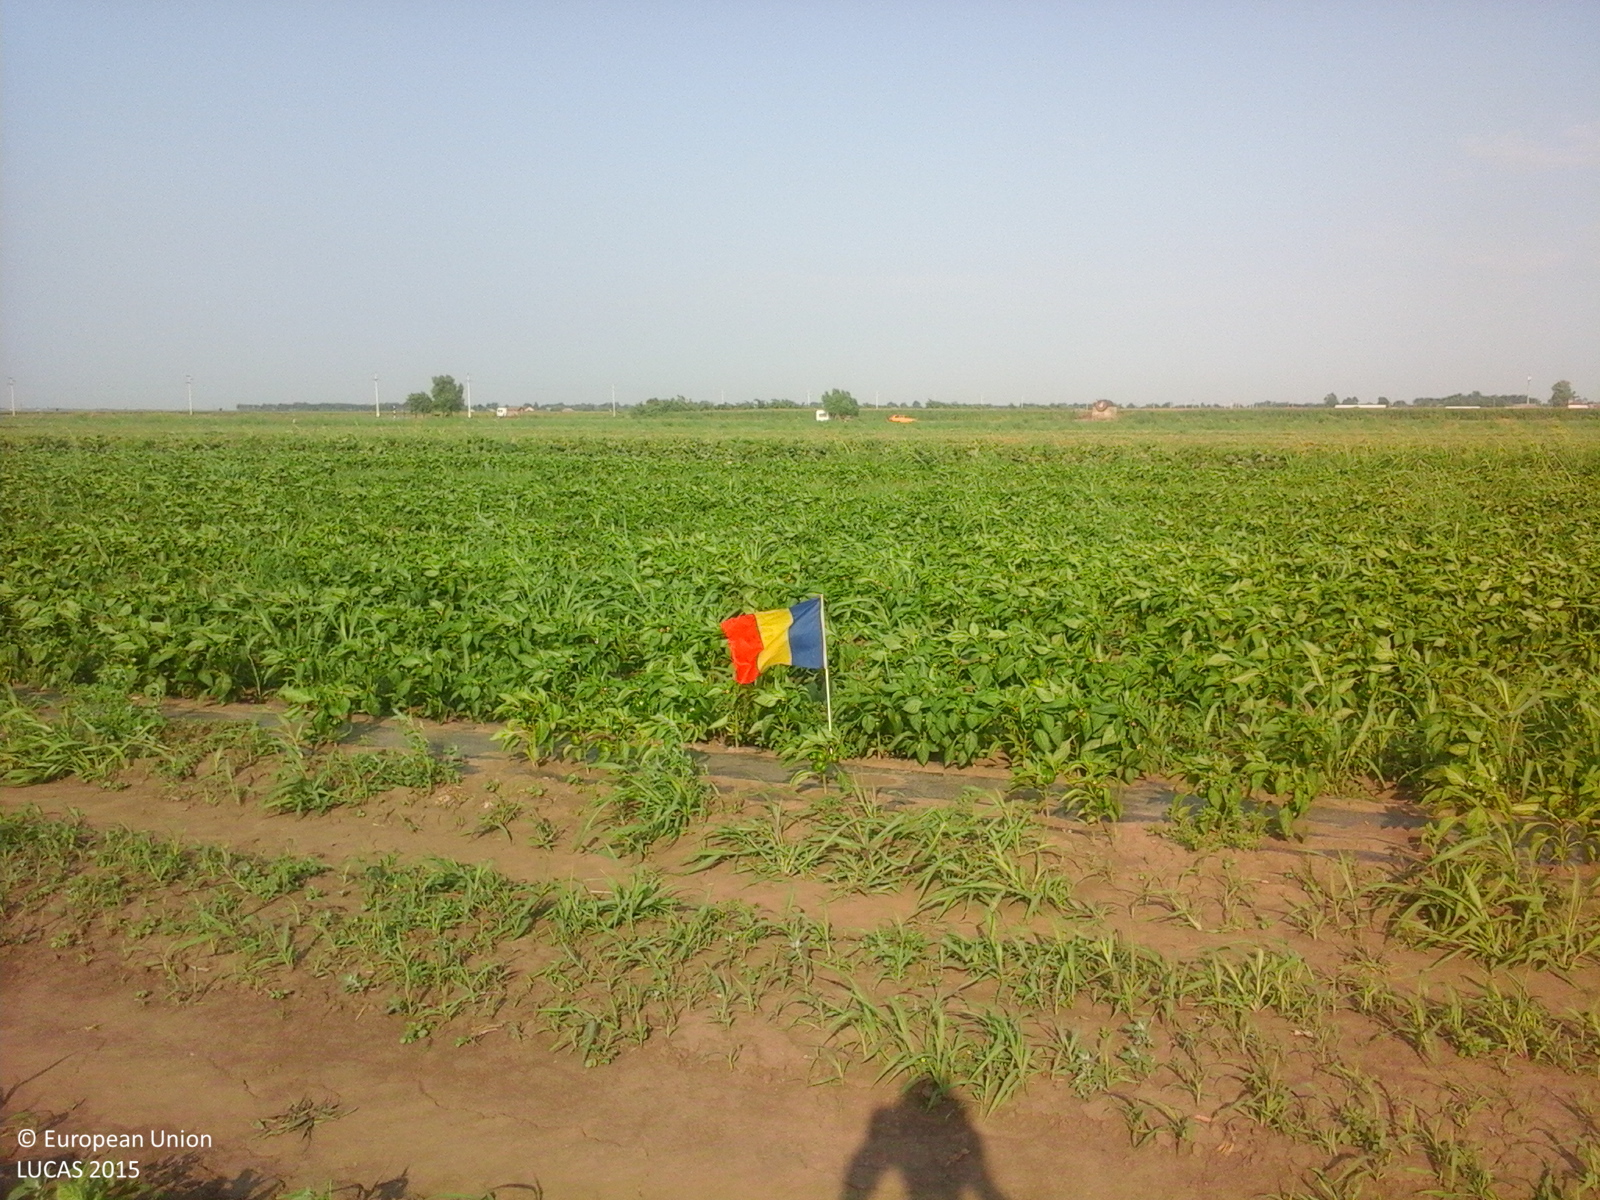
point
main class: Cropland
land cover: Other fresh vegetables
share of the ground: > 75 %
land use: Agriculture (excluding fallow land and kitchen gardens)
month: July
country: RO
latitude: 44.6114
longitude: 27.2102
